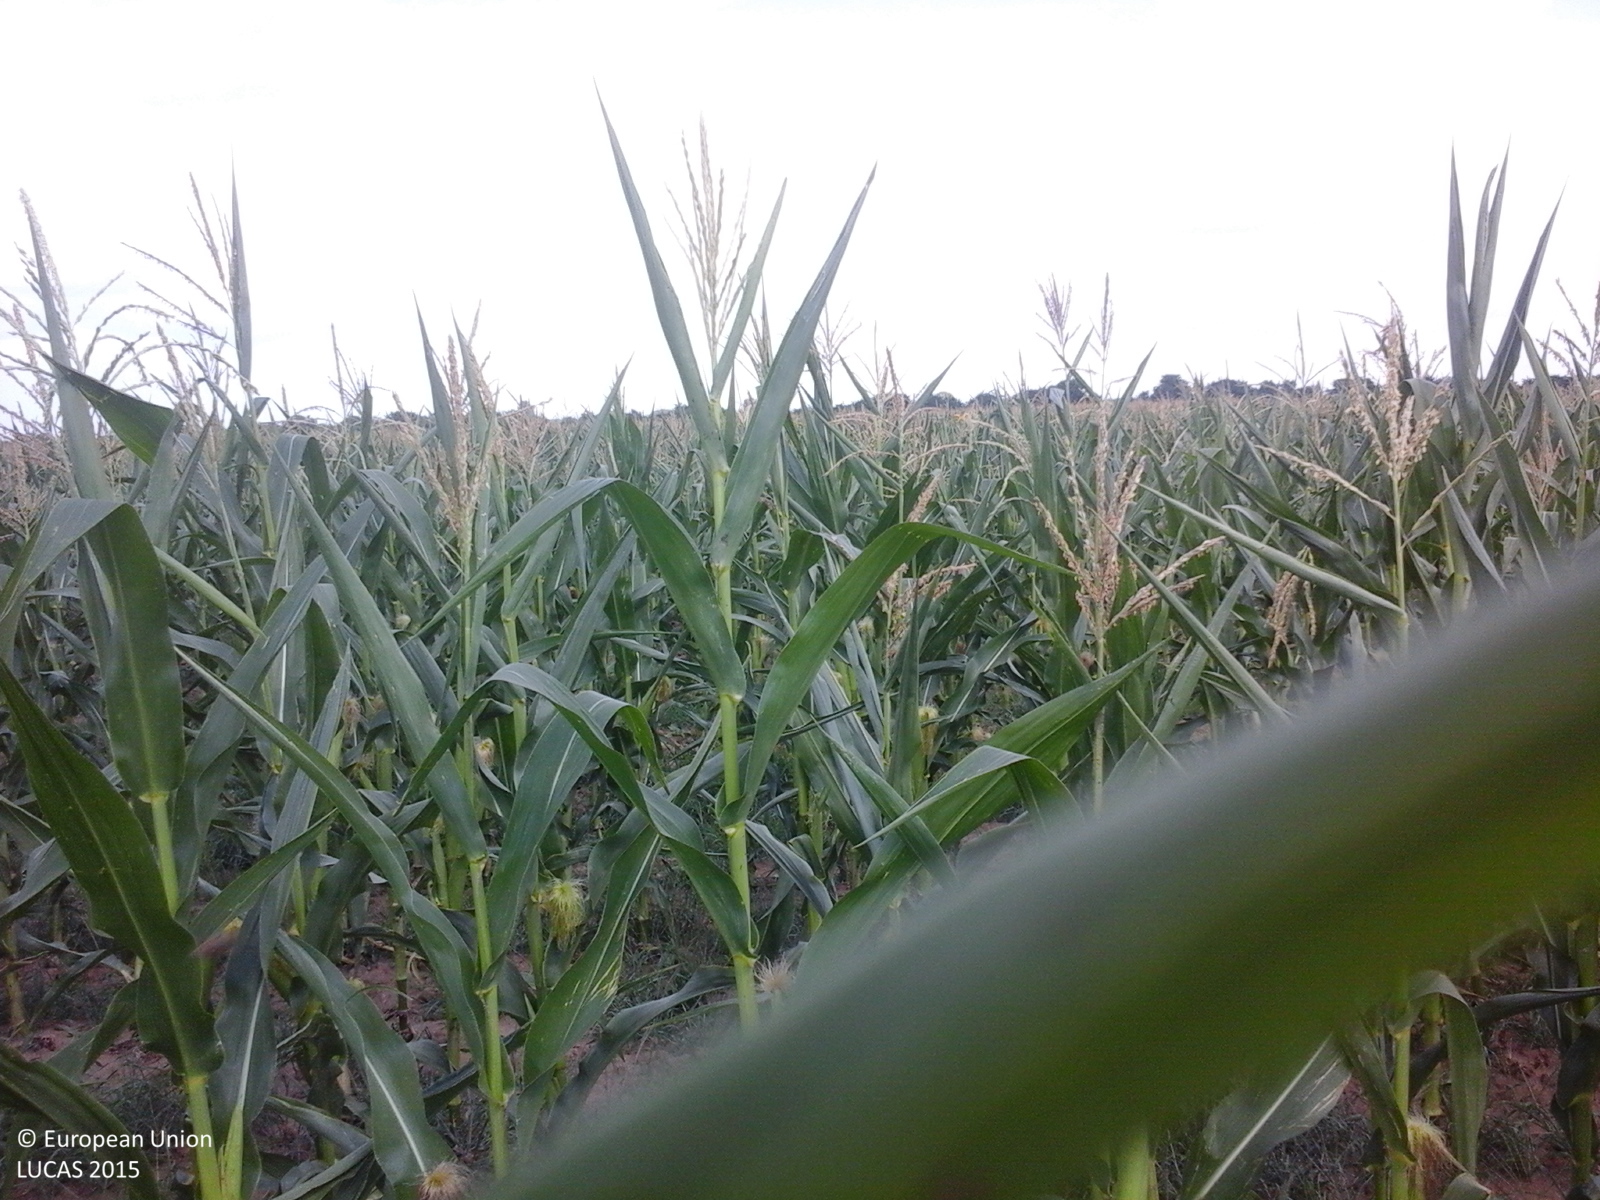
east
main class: Cropland
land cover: Maize
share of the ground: > 75 %
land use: Agriculture (excluding fallow land and kitchen gardens)
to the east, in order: Maize; Sunflower; Maize; Common wheat; Spontaneously vegetated surfaces
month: July
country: RO
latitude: 43.8605
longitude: 24.0794
